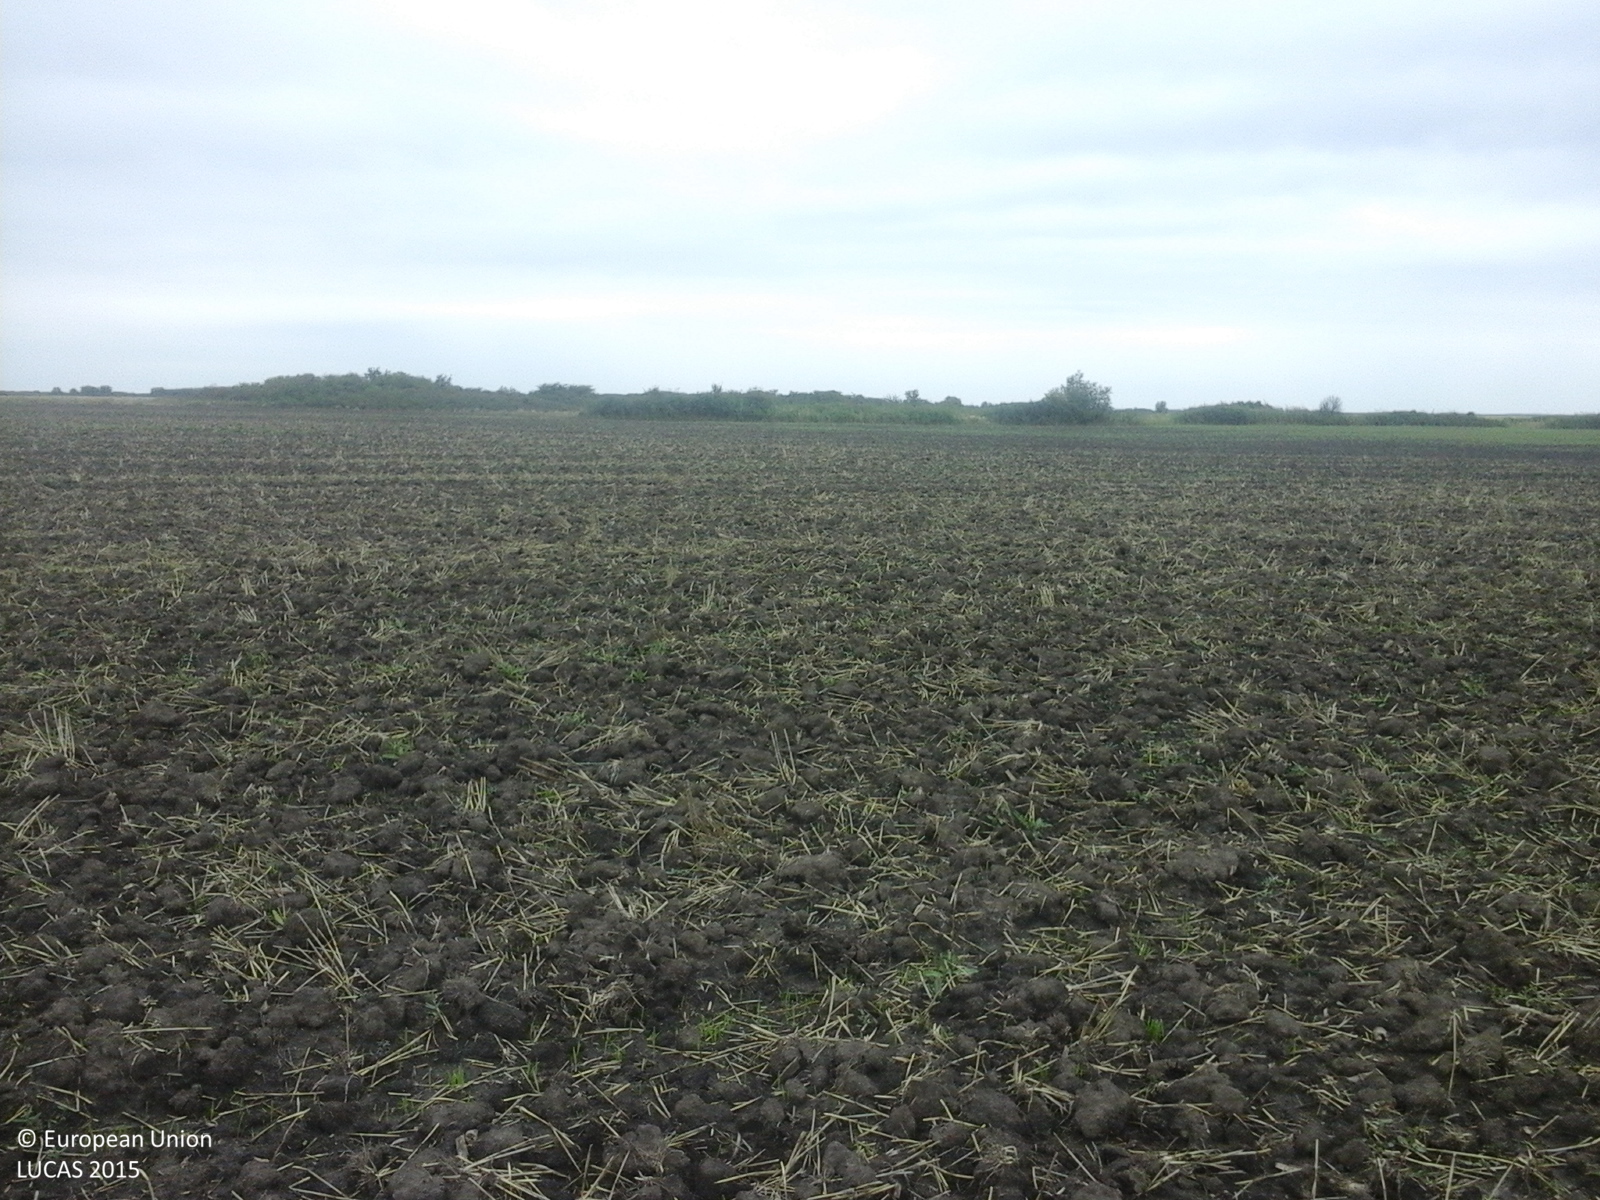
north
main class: Cropland
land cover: Common wheat
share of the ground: < 10 %
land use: Agriculture (excluding fallow land and kitchen gardens)
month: August
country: RO
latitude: 45.3648
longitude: 20.9927
